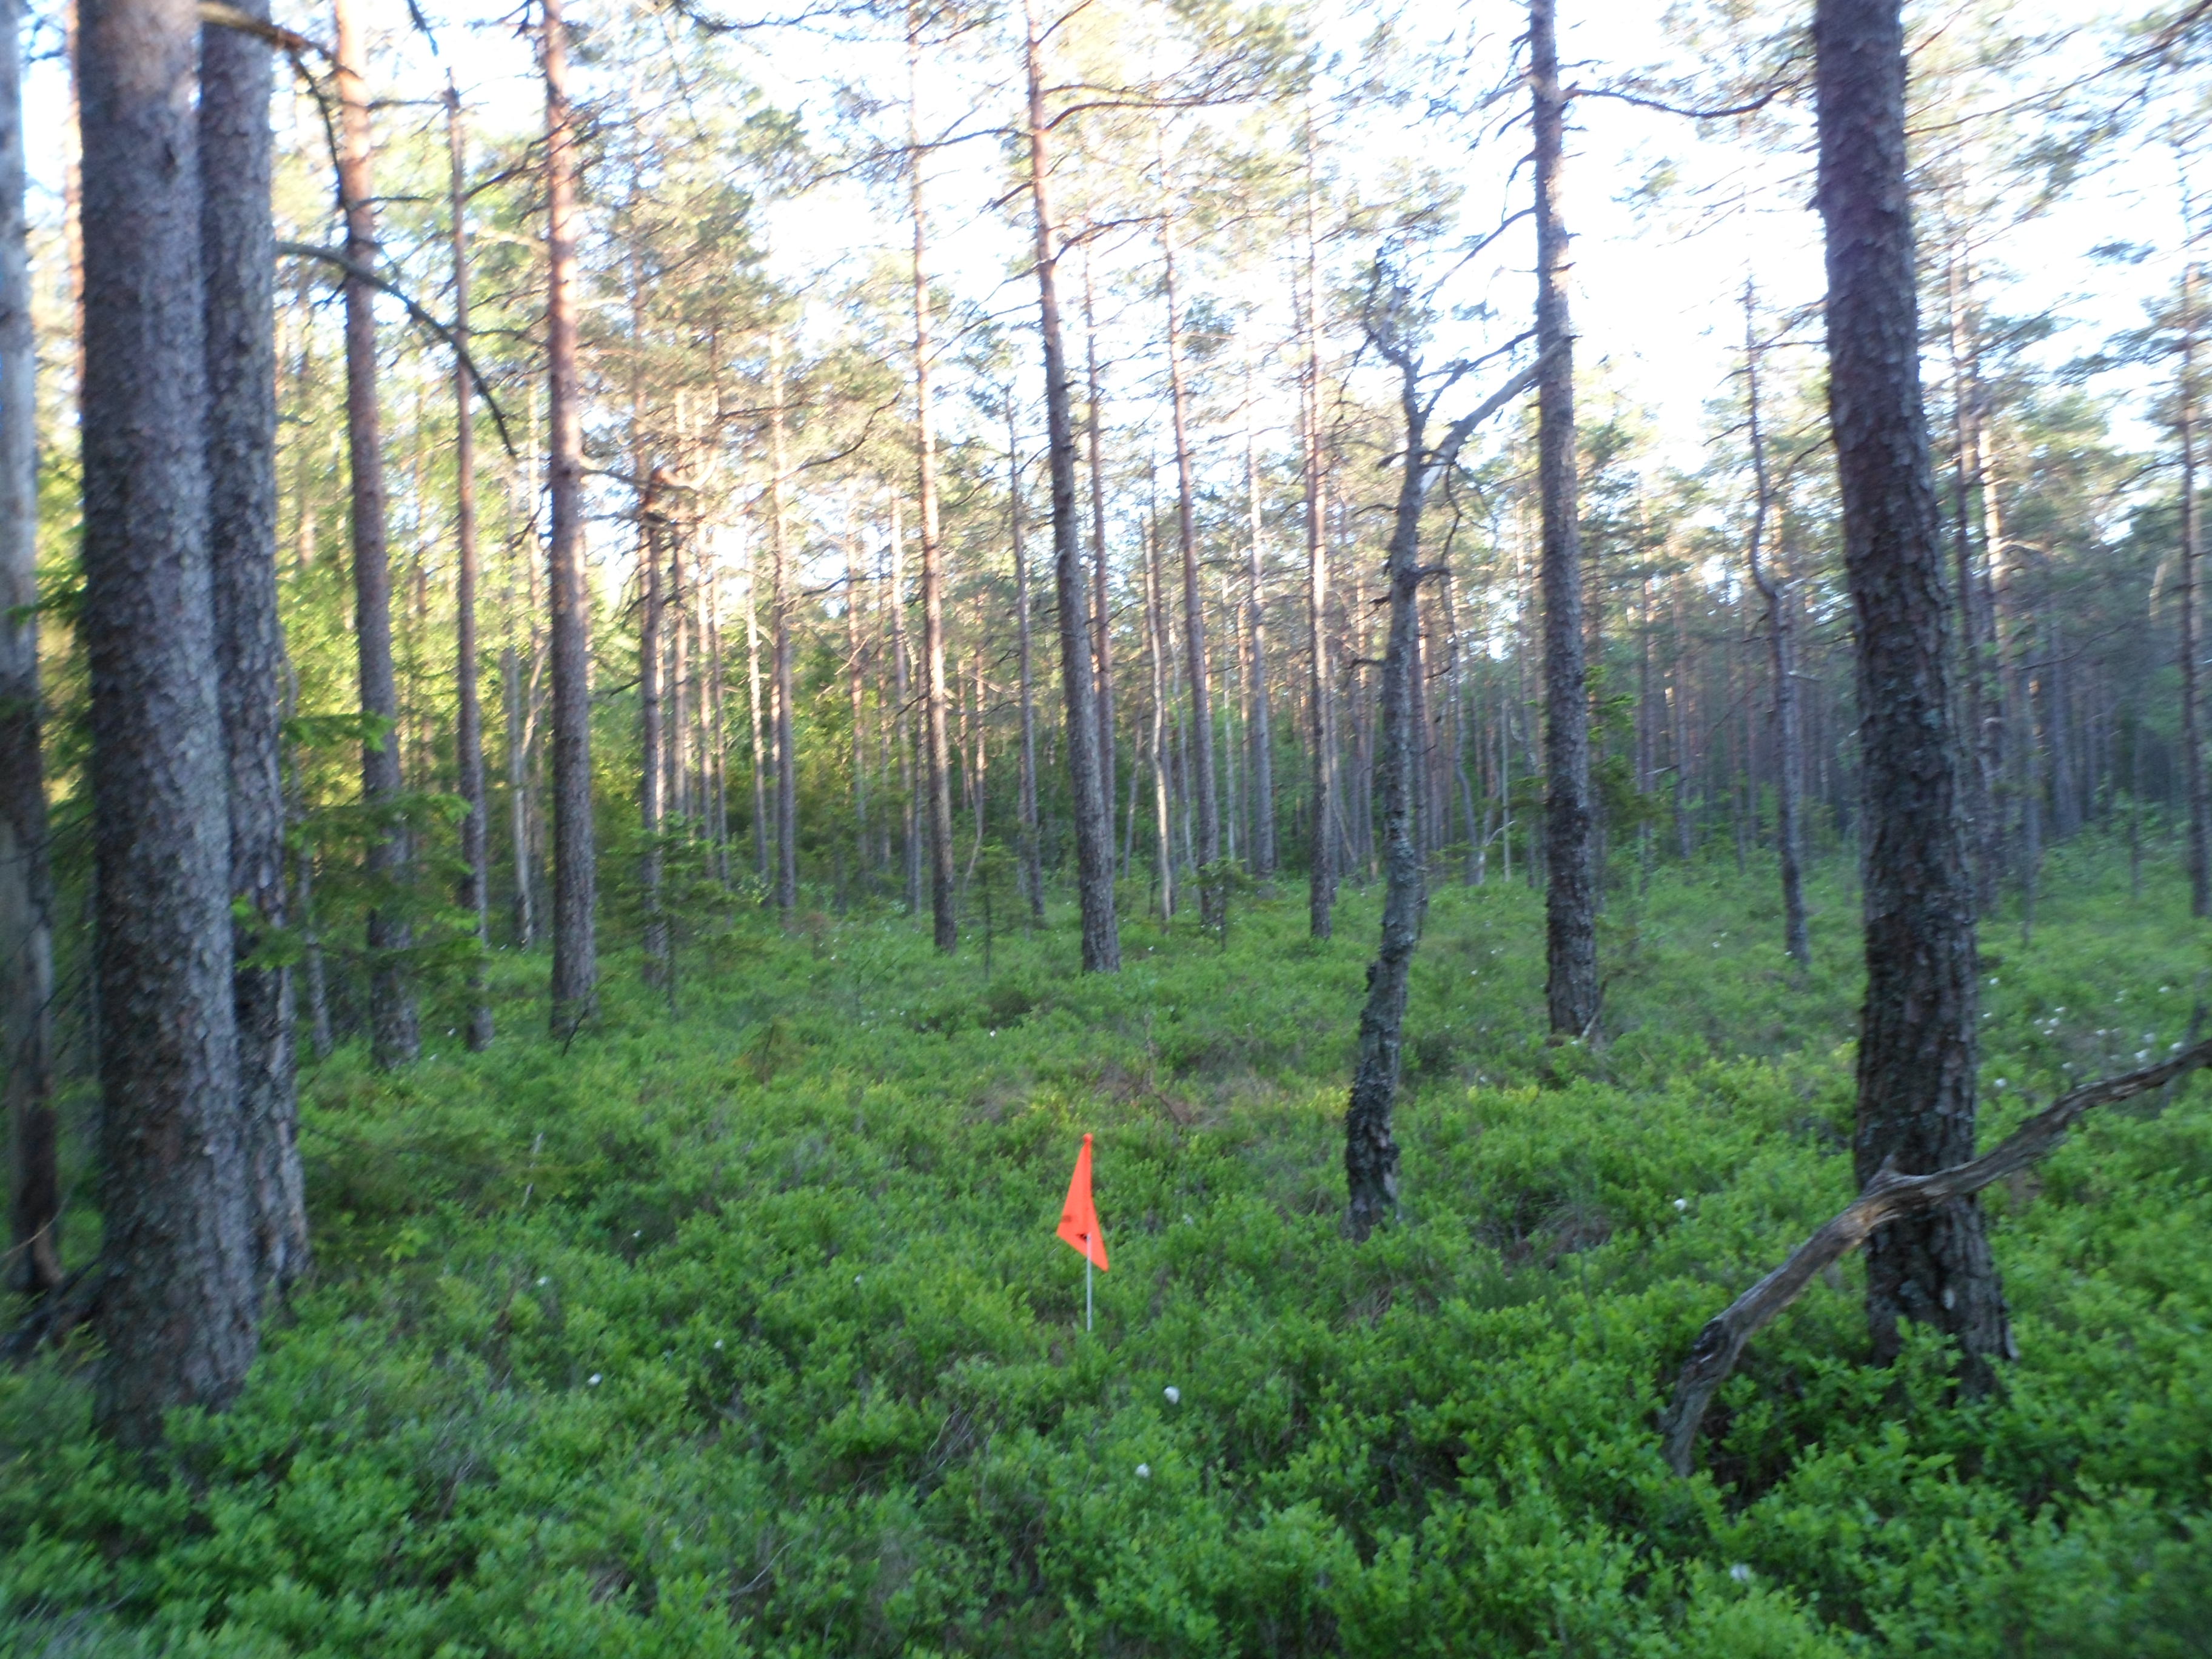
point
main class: Woodland
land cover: Pine dominated coniferous woodland
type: boreal forest
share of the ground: 25 - 50 %
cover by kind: coniferous forest trees 40 %, shrubs 25 %, herbaceous plants 15 %, lichens and mosses 15 %, broadleaved forest trees 5 %
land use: Forestry
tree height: > 5 m
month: June
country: SE
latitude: 57.4962
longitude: 13.9166
